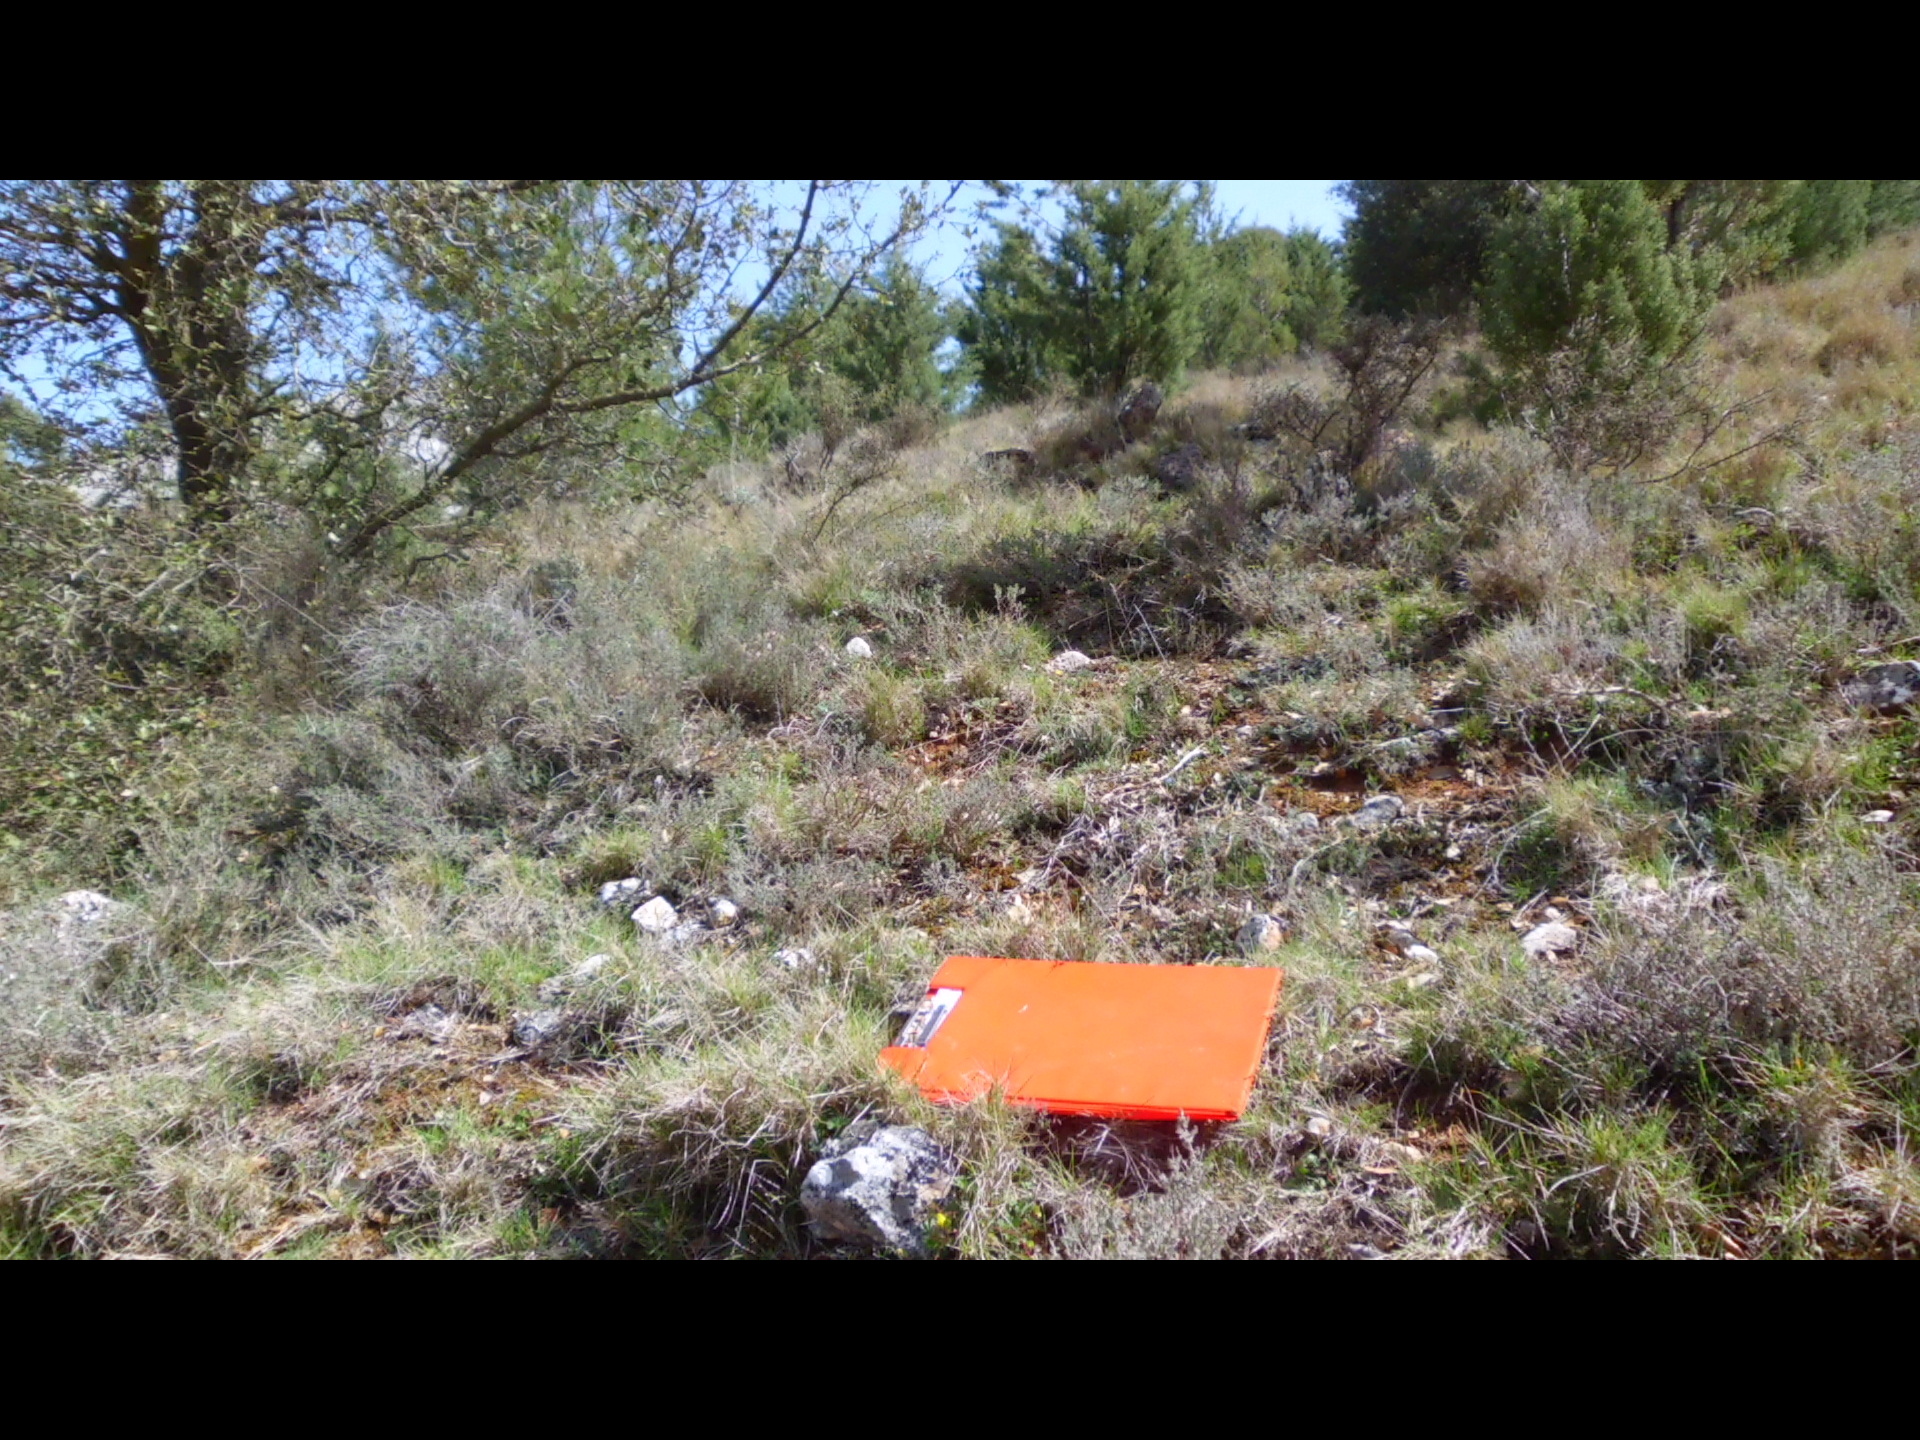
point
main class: Shrubland
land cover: Shrubland with sparse tree cover
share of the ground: > 75 %
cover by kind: herbaceous plants 60 %, shrubs 35 %, coniferous forest trees 5 %
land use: Agriculture (excluding fallow land and kitchen gardens)
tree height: < 5 m
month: April
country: ES
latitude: 42.5462
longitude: -3.3925
